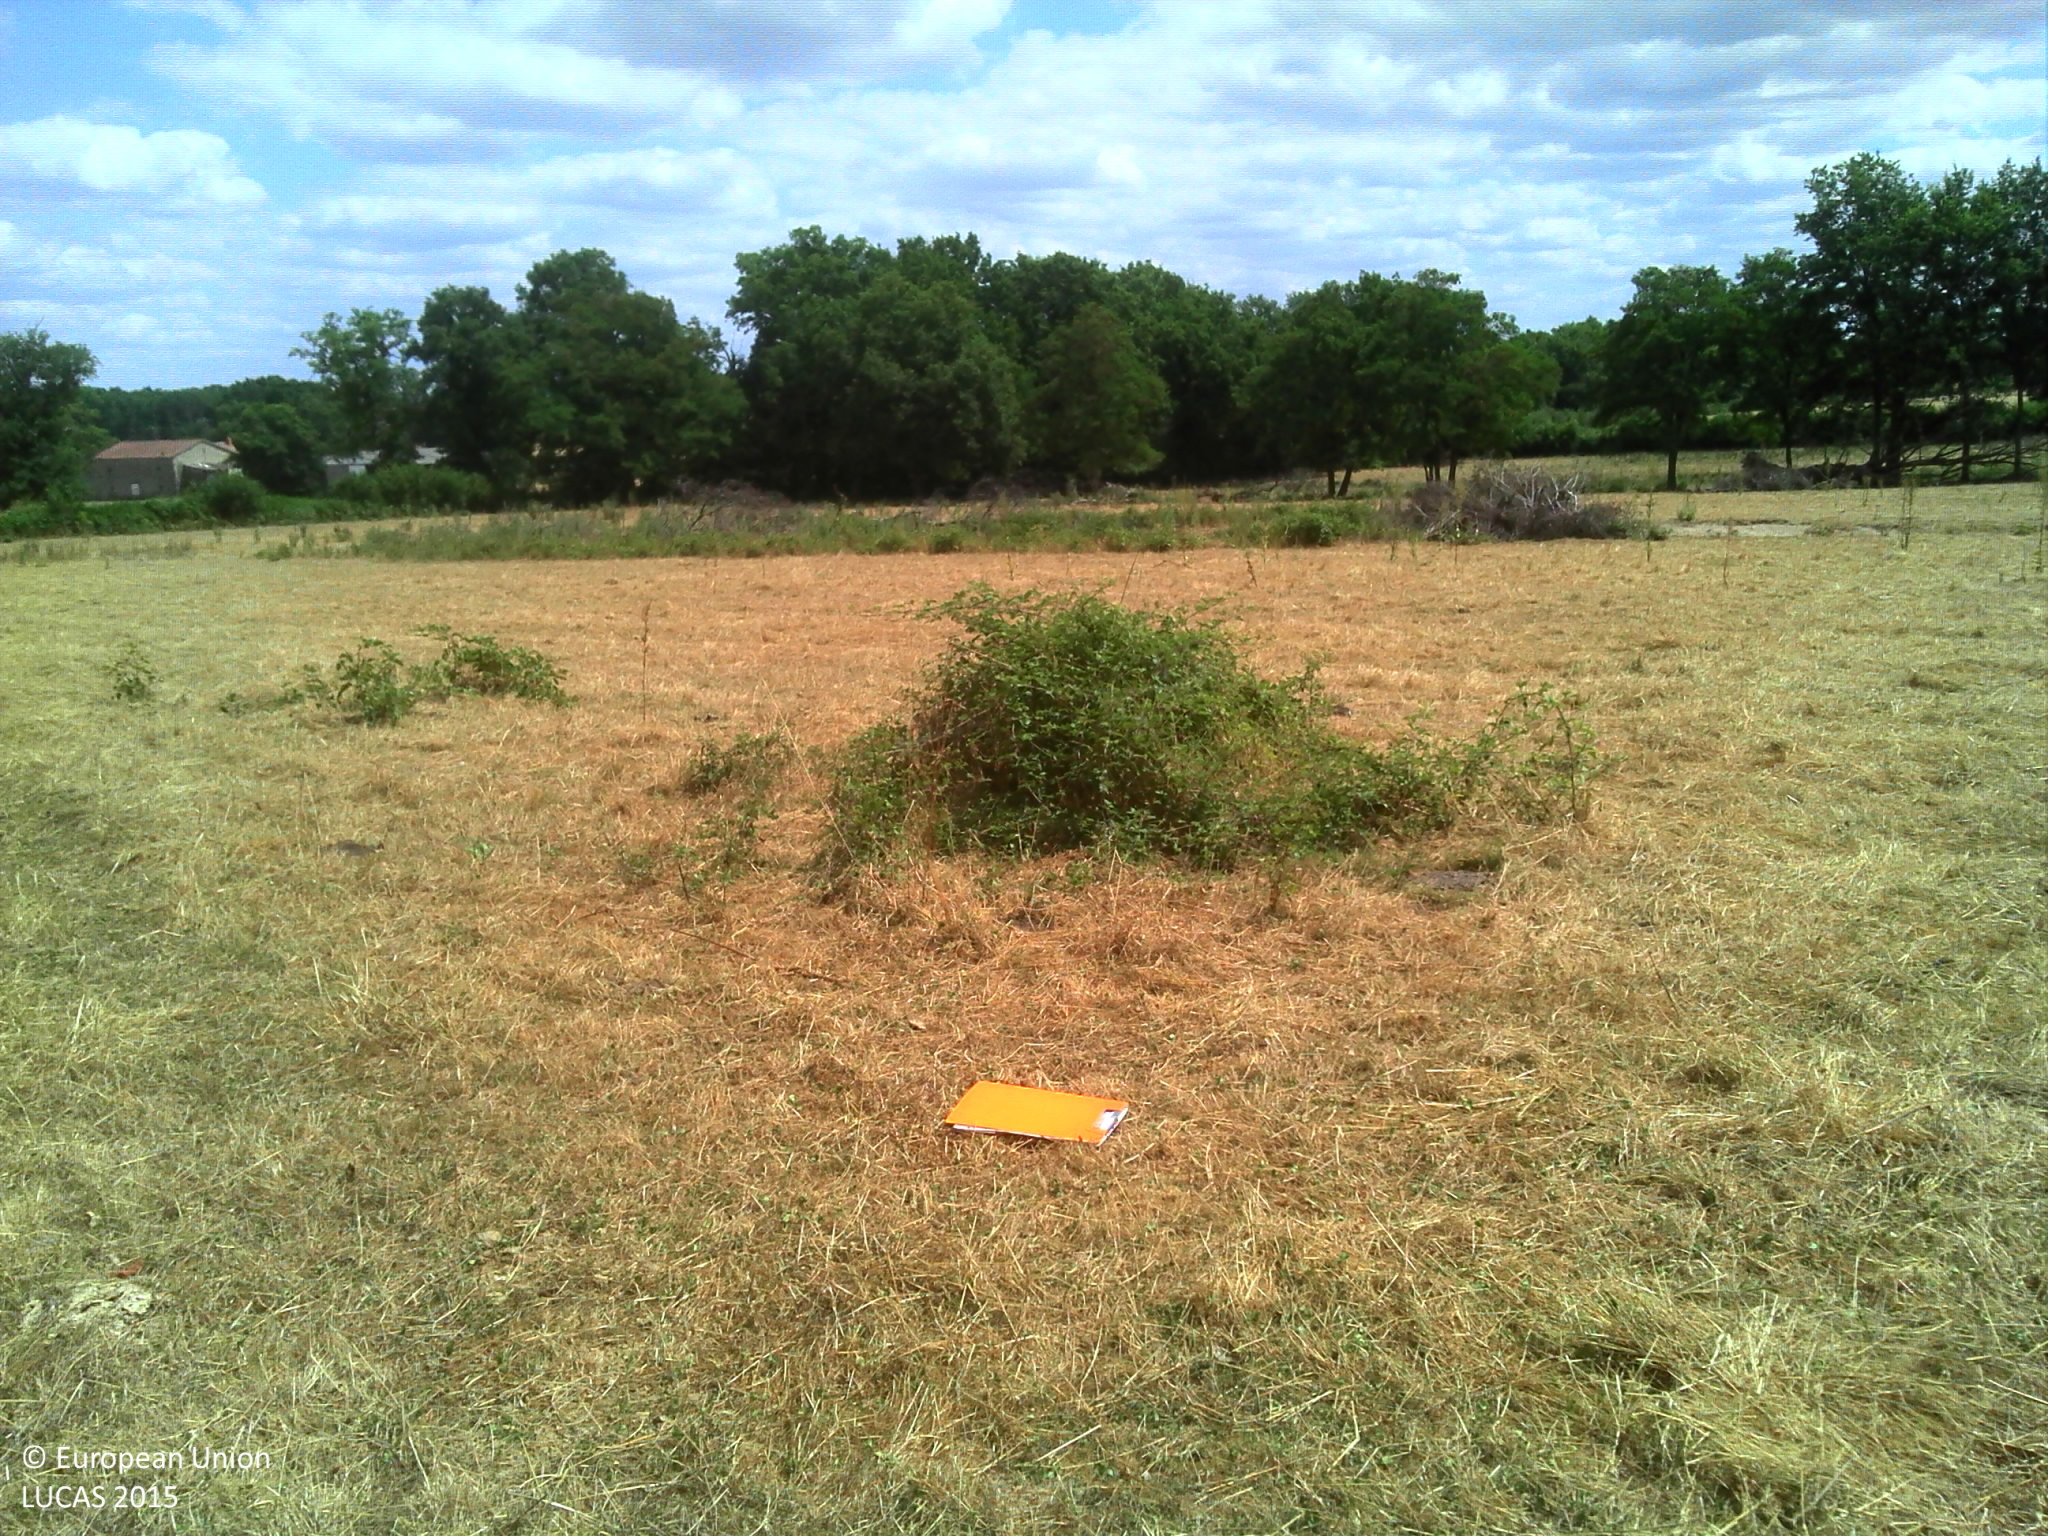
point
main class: Grassland
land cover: Grassland without tree/shrub cover
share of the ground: > 75 %
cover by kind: herbaceous plants 95 %, shrubs 5 %
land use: Agriculture (excluding fallow land and kitchen gardens)
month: July
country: FR
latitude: 46.4858
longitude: 2.7663
